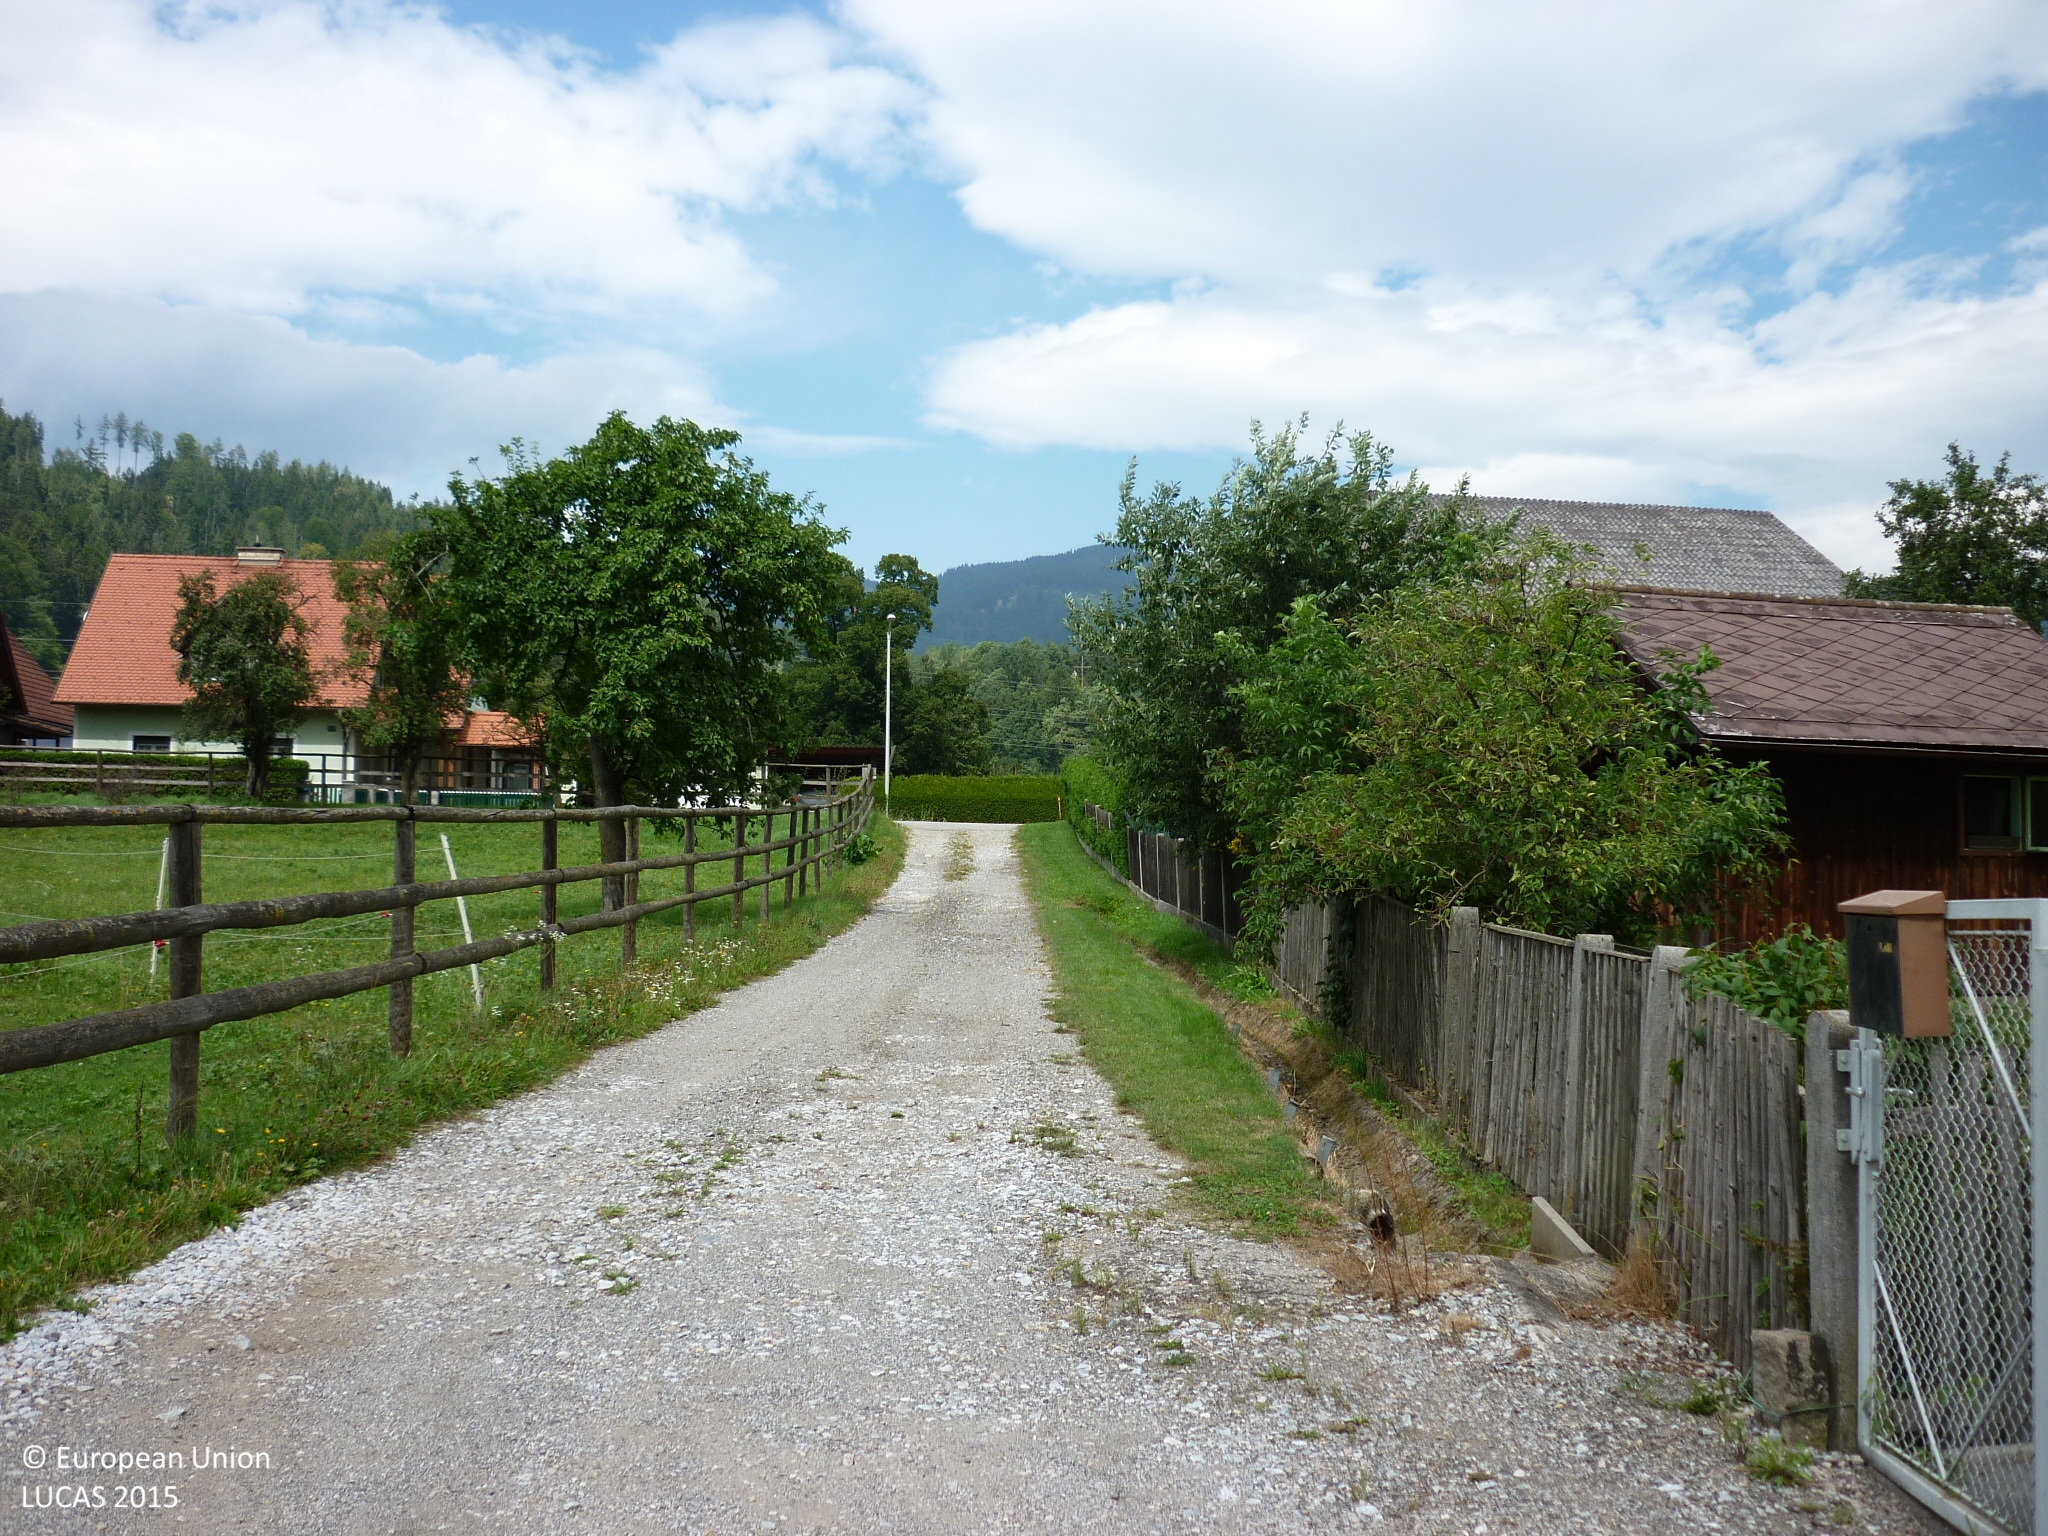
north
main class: Grassland
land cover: Grassland with sparse tree/shrub cover
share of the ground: > 75 %
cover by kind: herbaceous plants 85 %, shrubs 10 %, broadleaved forest trees 5 %
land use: Residential
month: August
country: AT
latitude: 47.4639
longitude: 15.3202
